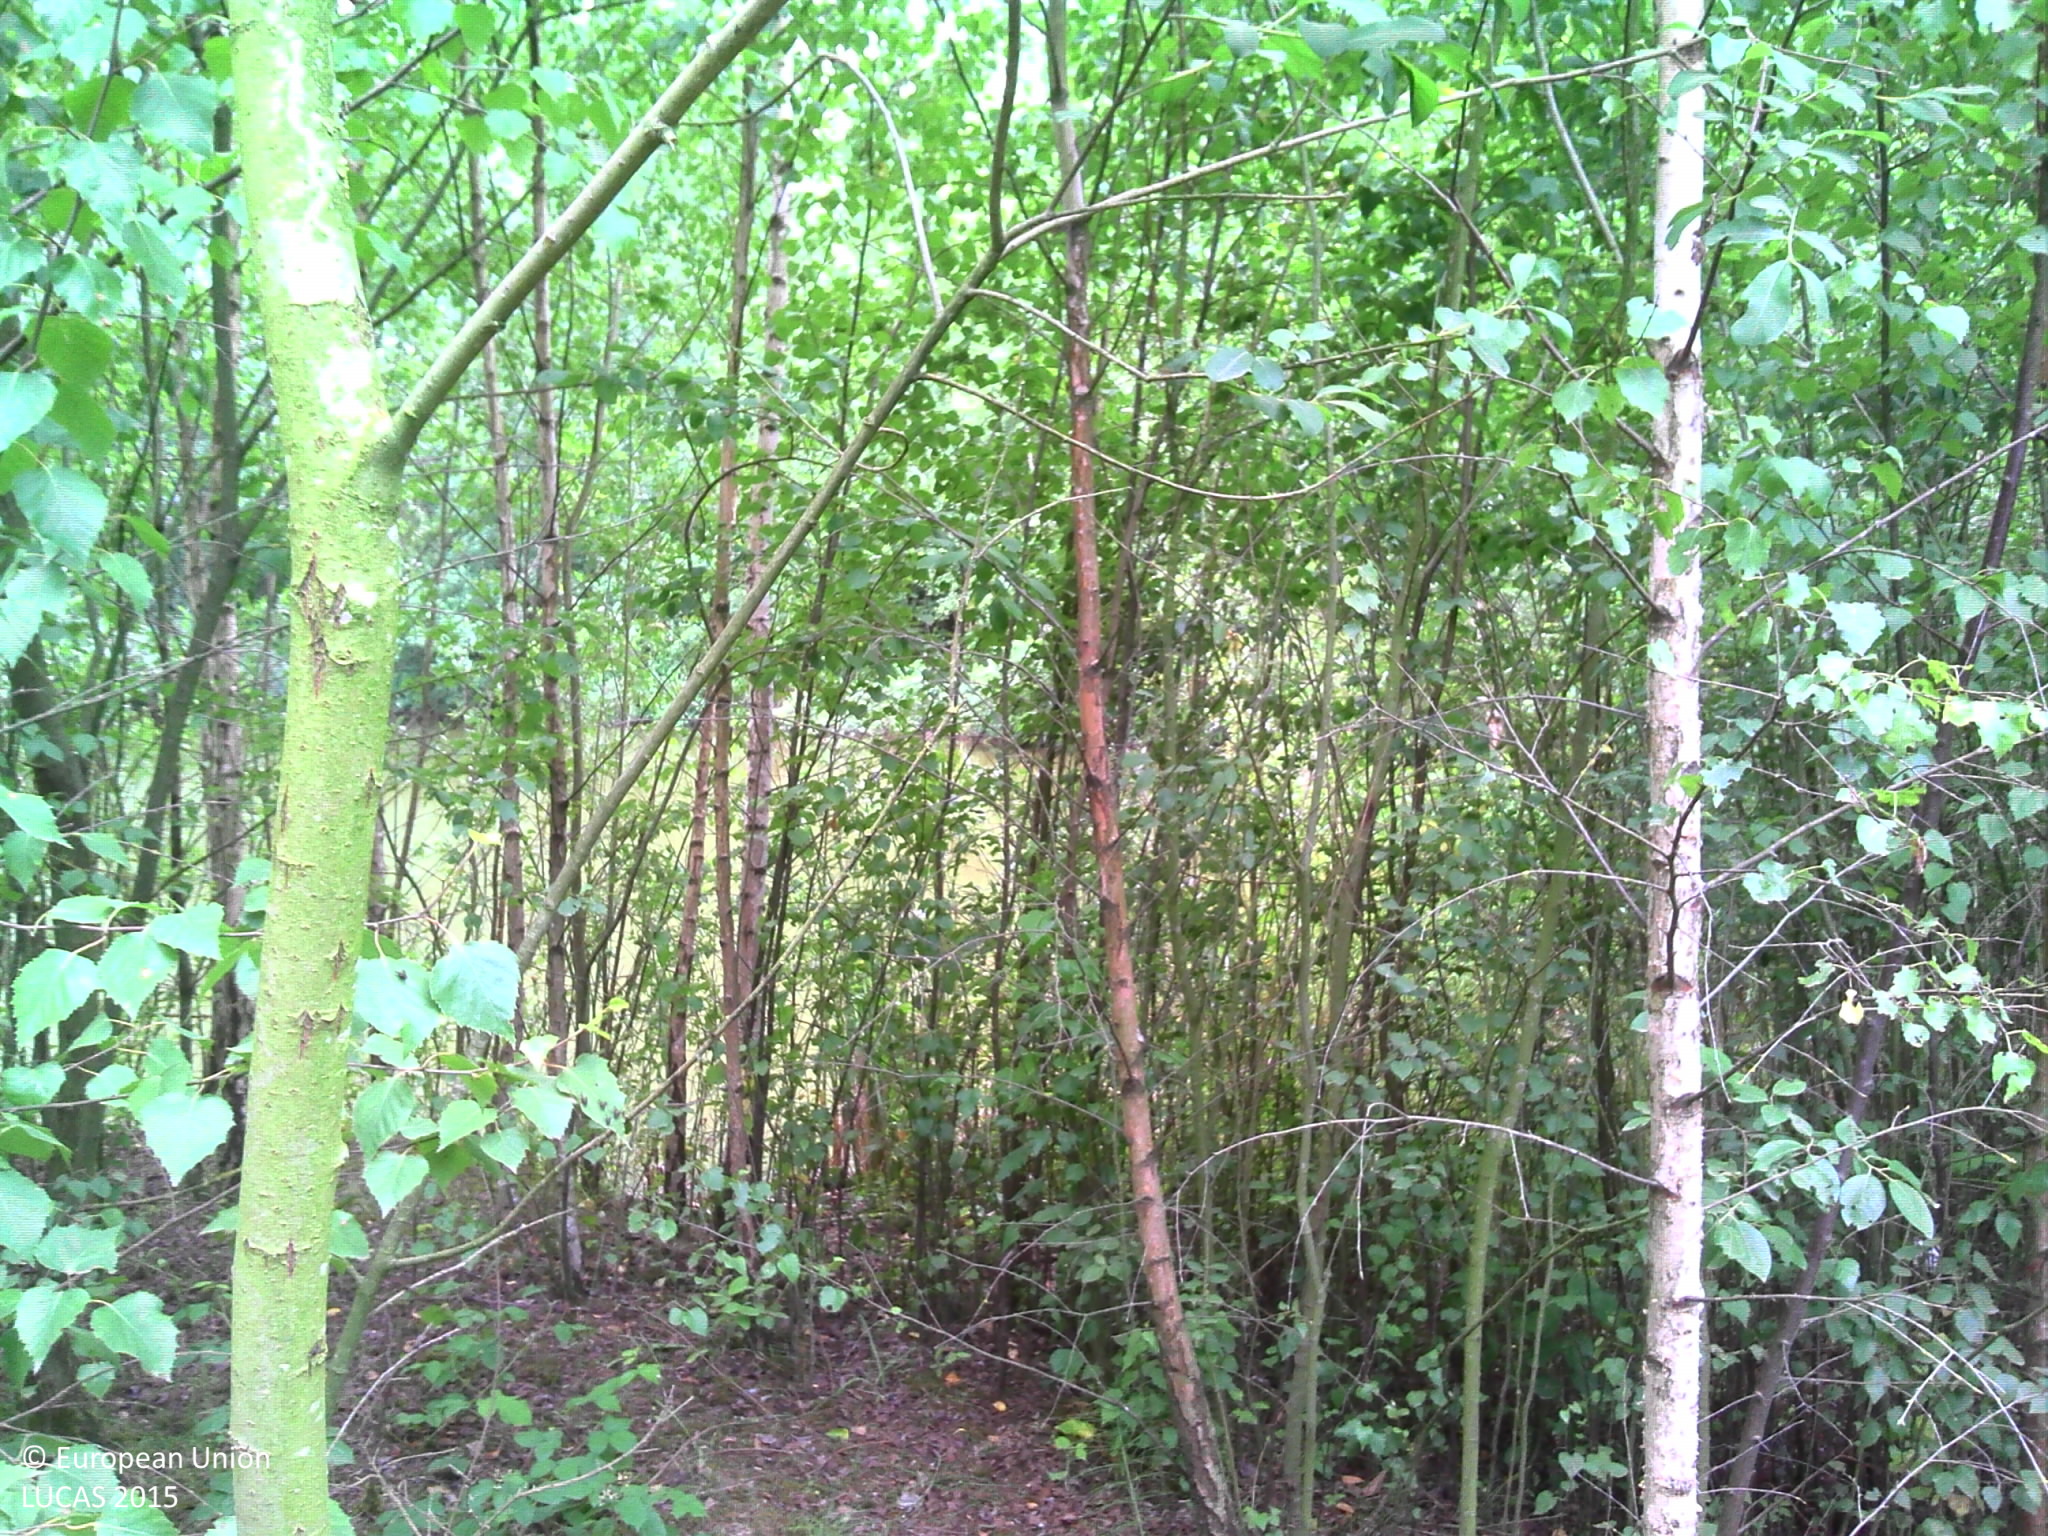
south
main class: Woodland
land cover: Broadleaved woodland
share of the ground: > 75 %
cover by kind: broadleaved forest trees 70 %, herbaceous plants 30 %
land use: Semi-natural and natural areas not in use
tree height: > 5 m
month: July
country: BE
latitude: 50.5591
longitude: 4.5613
